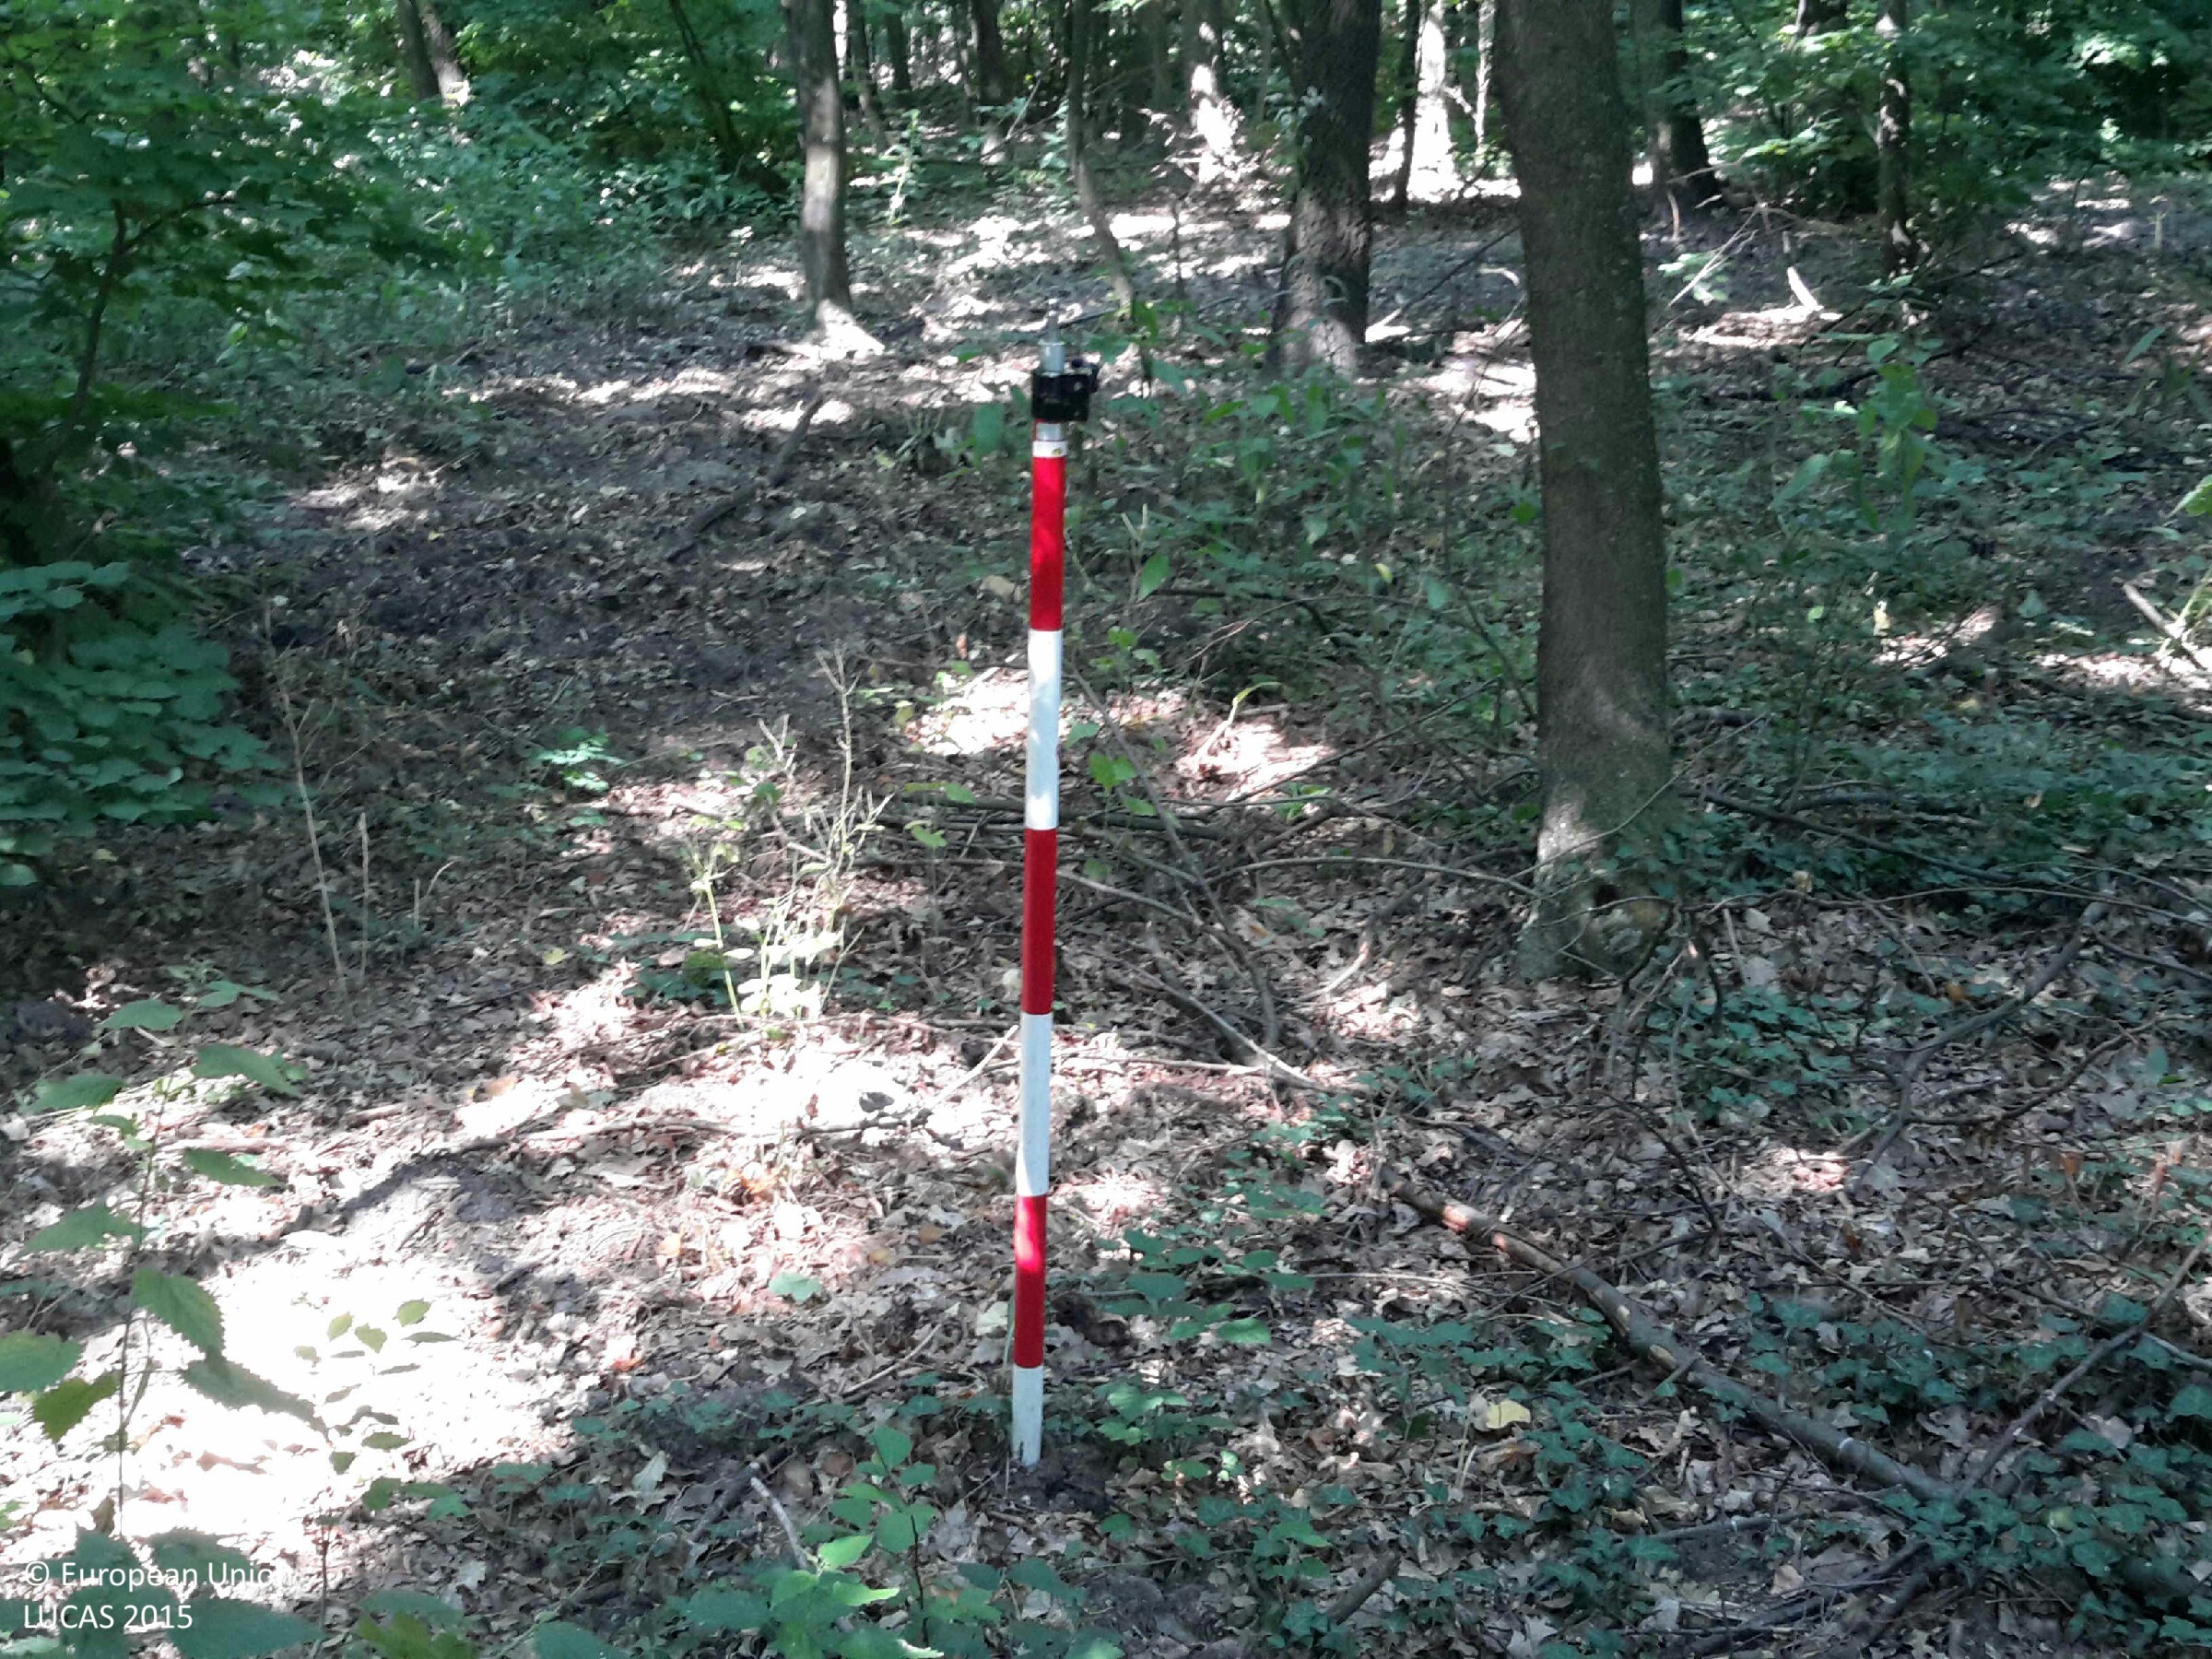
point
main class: Woodland
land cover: Broadleaved woodland
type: mesophytic deciduous forest
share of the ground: > 75 %
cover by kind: broadleaved forest trees 80 %, shrubs 10 %, herbaceous plants 10 %
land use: Forestry
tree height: > 5 m
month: June
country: HU
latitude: 47.2308
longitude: 17.4431
